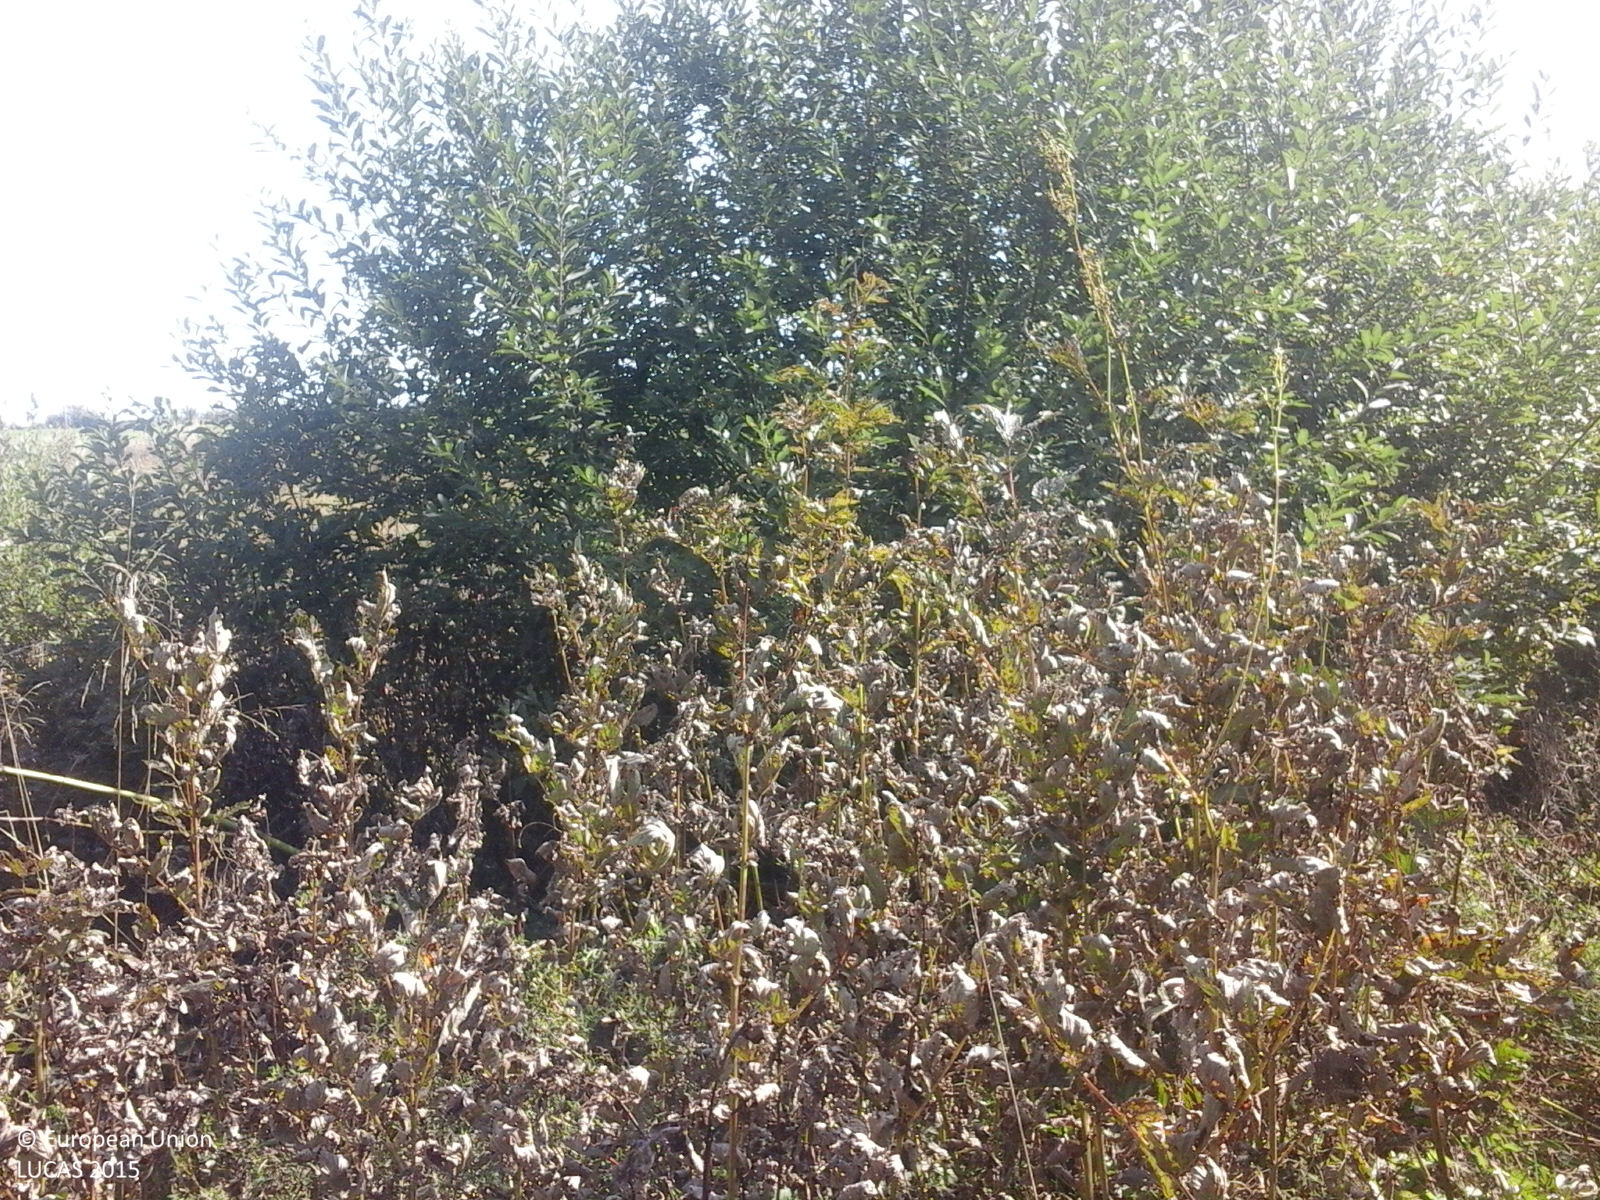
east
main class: Shrubland
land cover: Shrubland without tree cover
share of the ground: > 75 %
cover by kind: shrubs 100 %
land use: Fallow land
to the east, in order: Shrubland without tree cover; Spontaneously vegetated surfaces; Grassland without tree/shrub cover; Electric lines; Shruby margins; Paved roads, cycling and walking lanes; Ditches and canals; Shruby margins; Grassland without tree/shrub cover; Common wheat
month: September
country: RO
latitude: 46.7644
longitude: 23.0906
